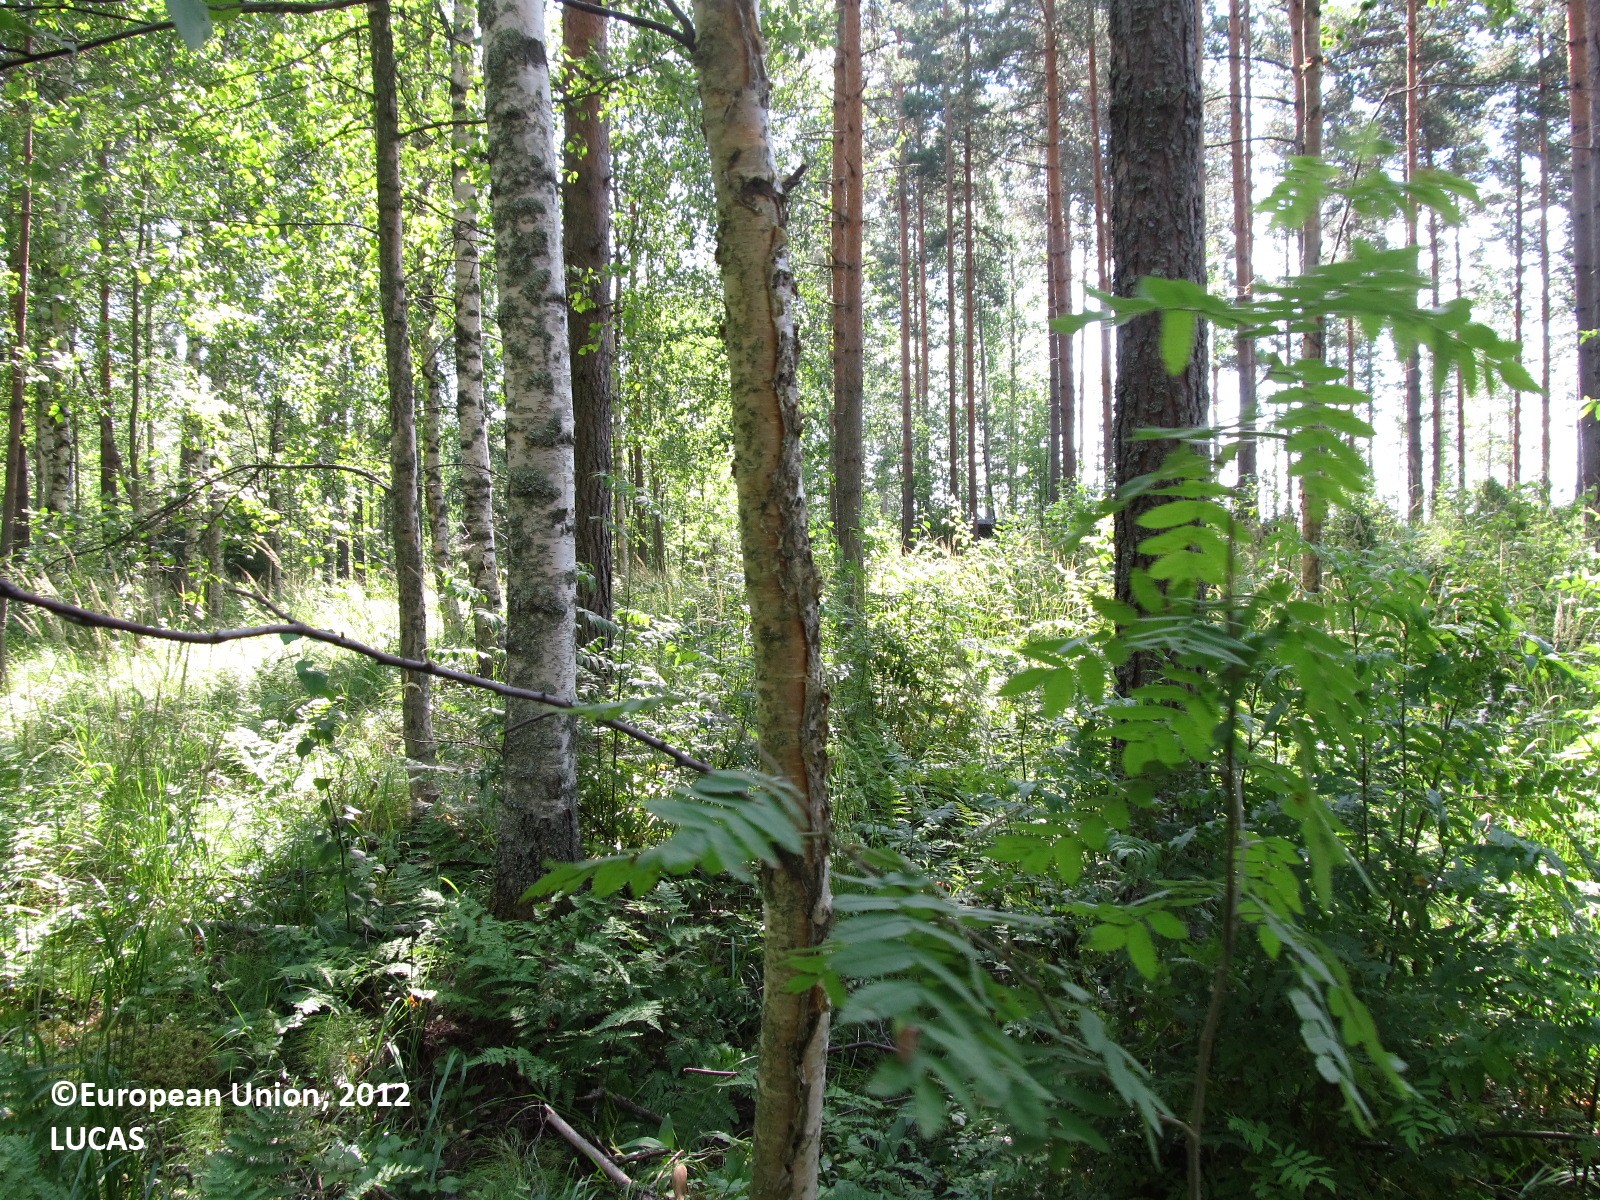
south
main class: Woodland
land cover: Pine dominated mixed woodland
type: boreal forest
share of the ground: 25 - 50 %
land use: Forestry
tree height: > 5 m
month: August
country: FI
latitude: 62.0943
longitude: 28.6955
